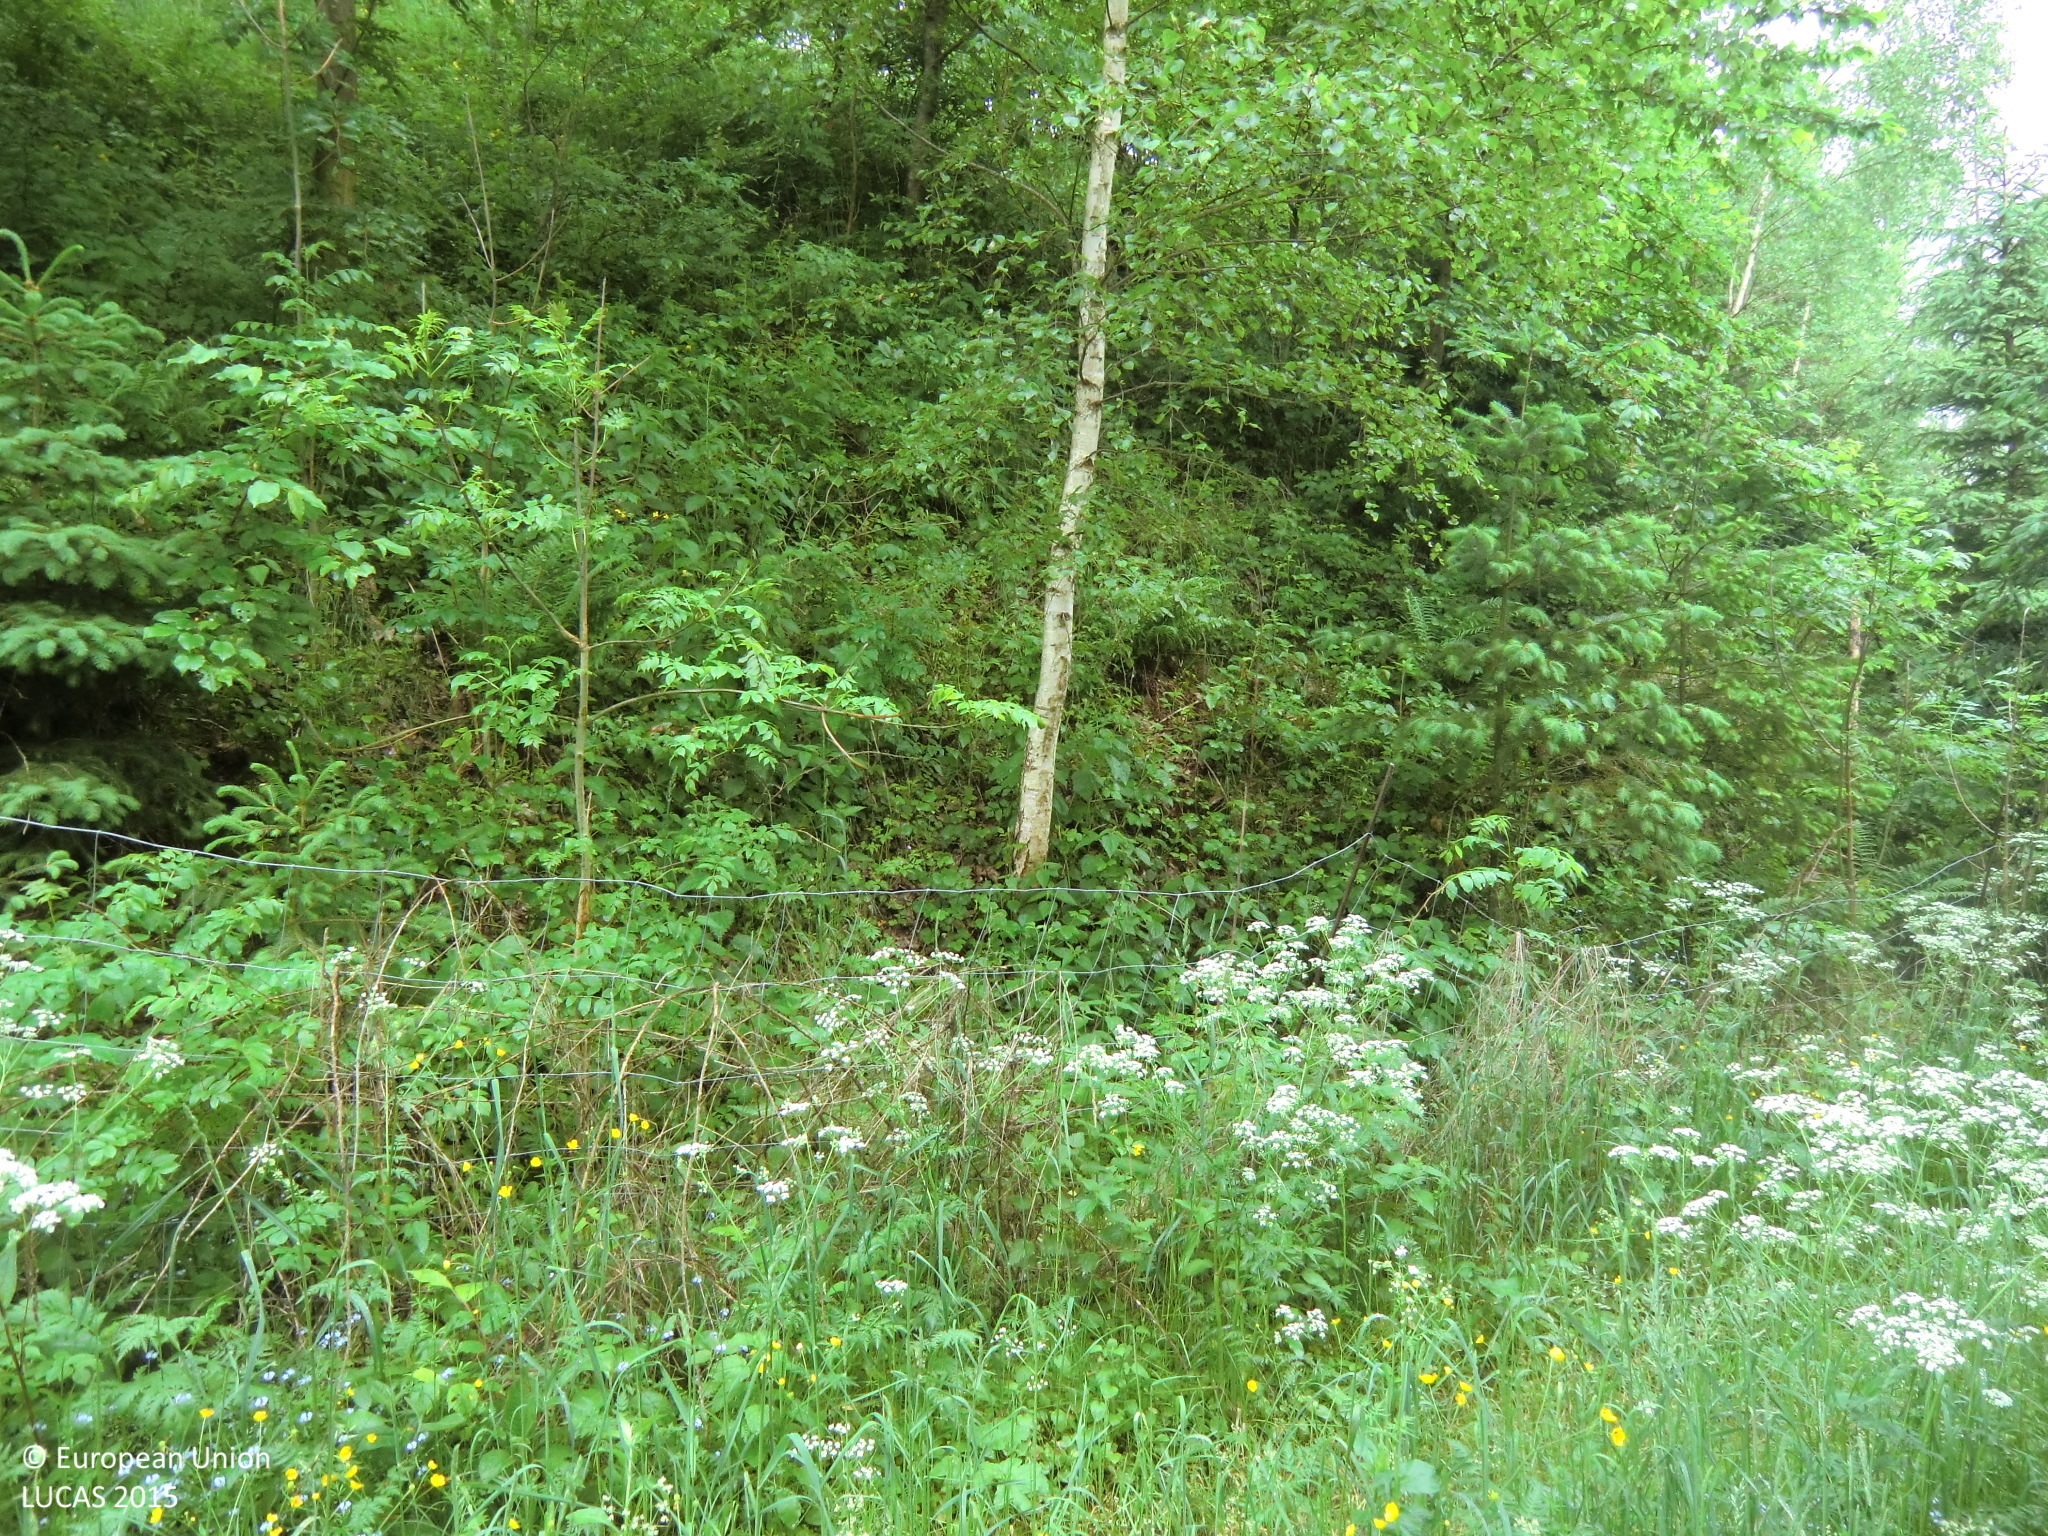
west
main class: Woodland
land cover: Spruce dominated mixed woodland
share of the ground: > 75 %
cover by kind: coniferous forest trees 60 %, broadleaved forest trees 20 %, shrubs 10 %, consolidated bare surface 10 %
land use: Forestry
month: May
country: AT
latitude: 48.3460
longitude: 14.5477
